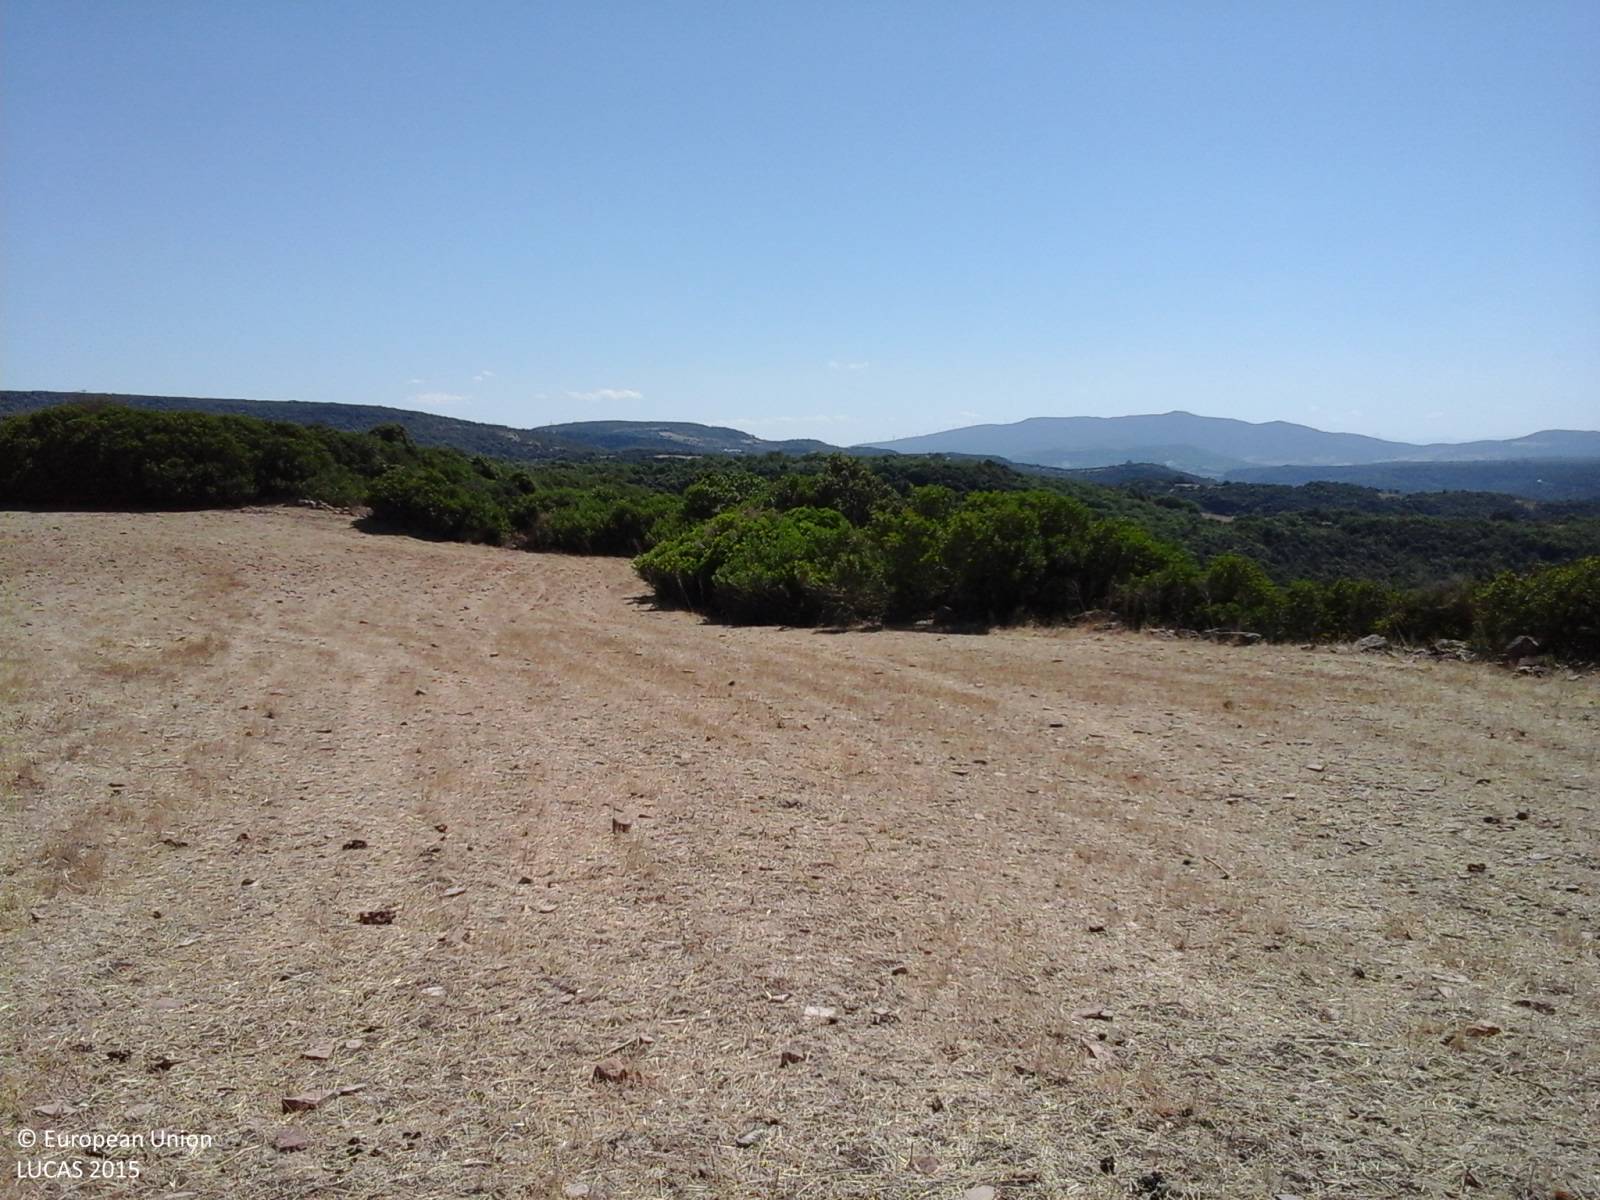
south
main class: Woodland
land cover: Broadleaved woodland
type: broadleaved evergreen forest
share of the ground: > 75 %
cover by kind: broadleaved forest trees 100 %
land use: Forestry
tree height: < 5 m
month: August
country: IT
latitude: 40.0800
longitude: 8.8919
